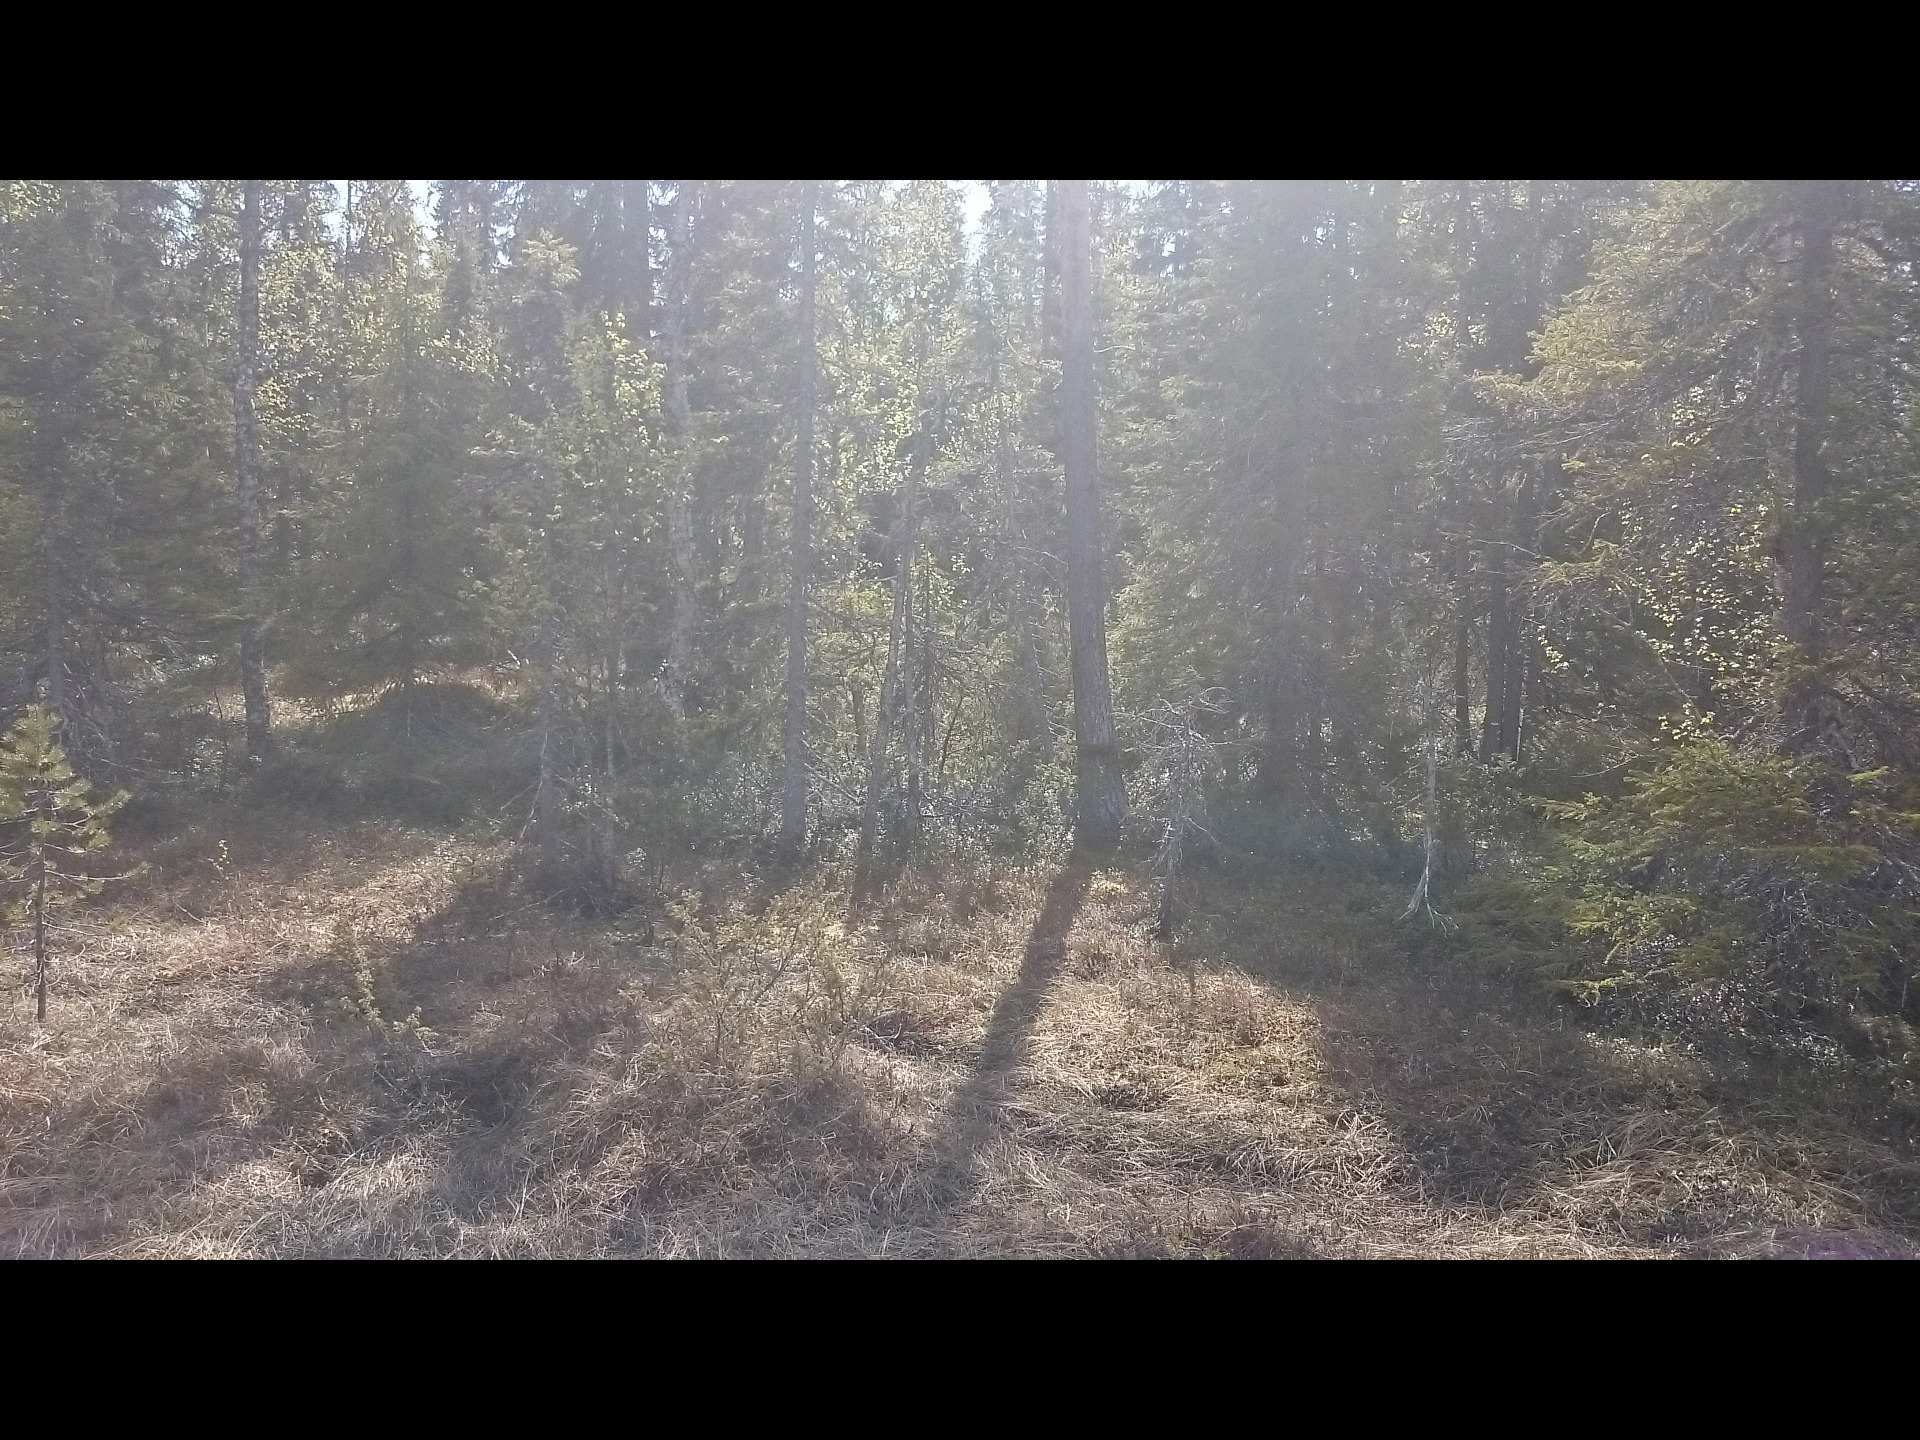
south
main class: Woodland
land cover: Pine dominated coniferous woodland
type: boreal forest
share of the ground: 50 - 75 %
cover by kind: coniferous forest trees 75 %, shrubs 25 %
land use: Forestry
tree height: > 5 m
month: June
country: SE
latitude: 63.5929
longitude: 13.8292
